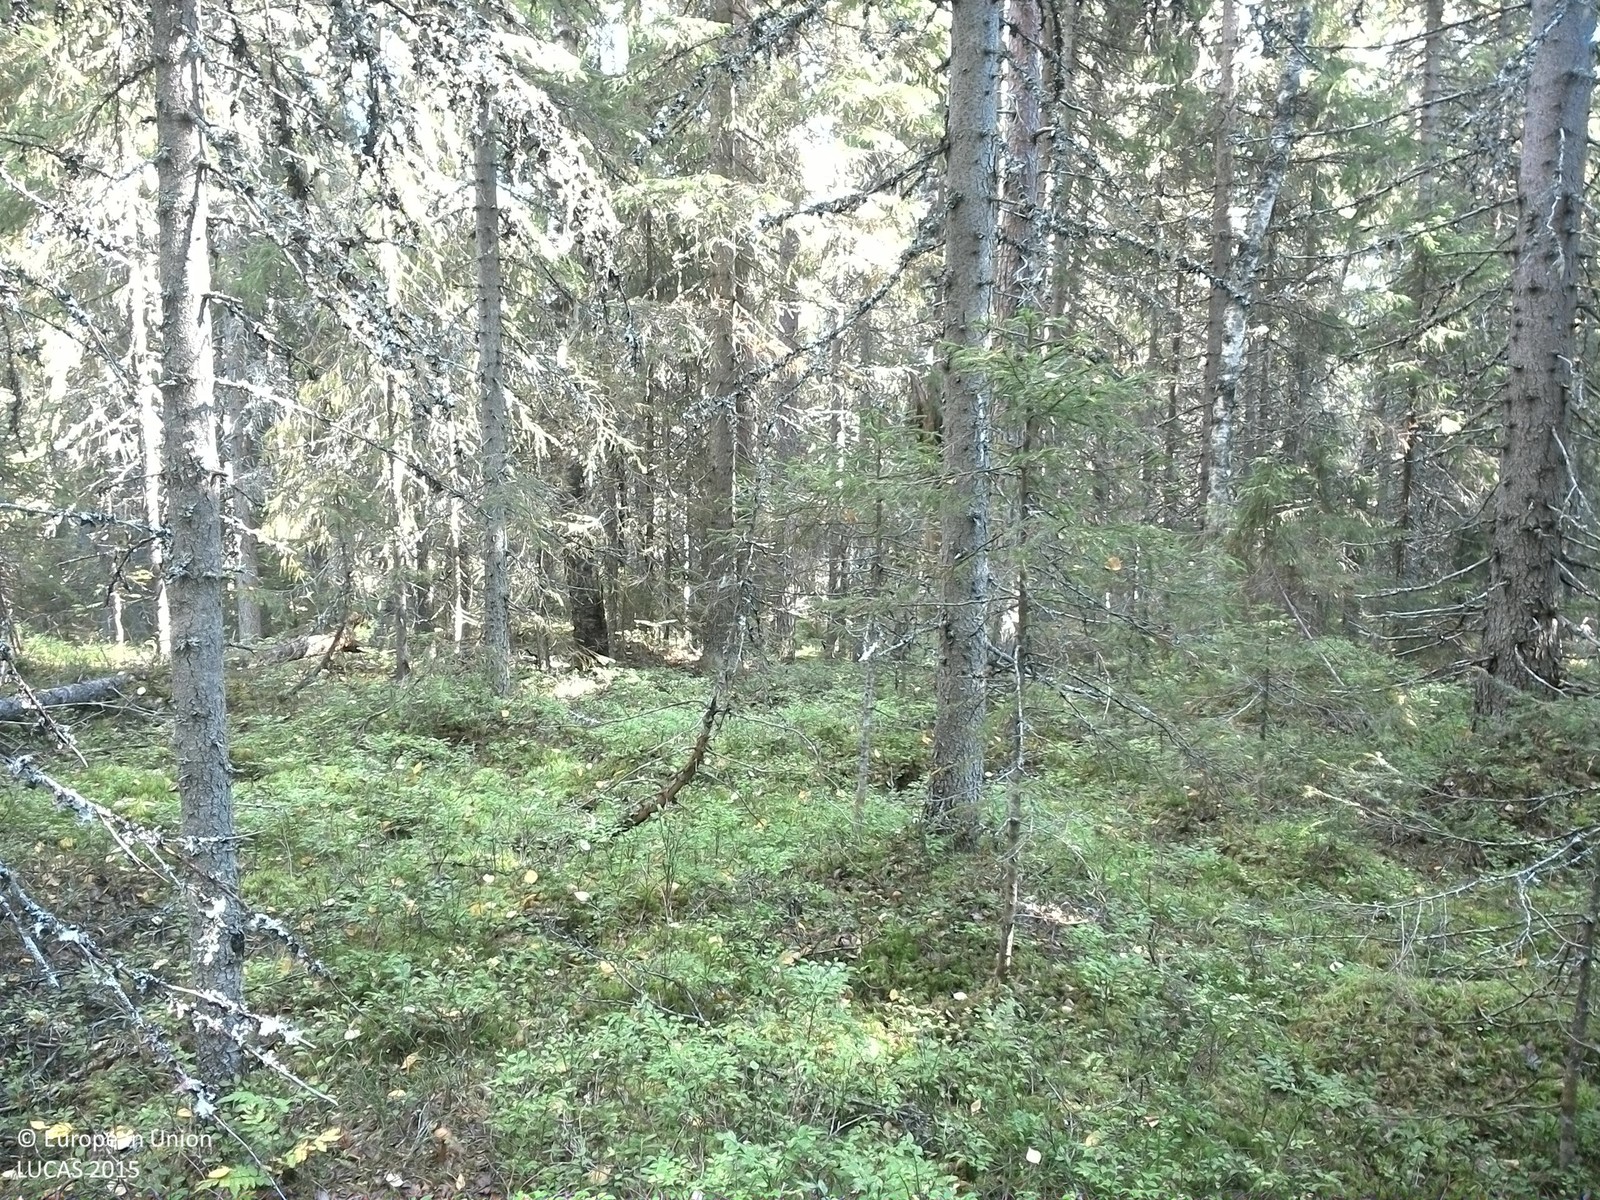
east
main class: Woodland
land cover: Spruce dominated coniferous woodland
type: boreal forest
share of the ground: 50 - 75 %
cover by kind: coniferous forest trees 60 %, shrubs 20 %, lichens and mosses 15 %, broadleaved forest trees 5 %
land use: Forestry
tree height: > 5 m
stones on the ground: 25 - 50 %
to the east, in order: Spruce dominated coniferous woodland; Pine dominated coniferous woodland
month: September
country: SE
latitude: 63.8824
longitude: 16.5479
